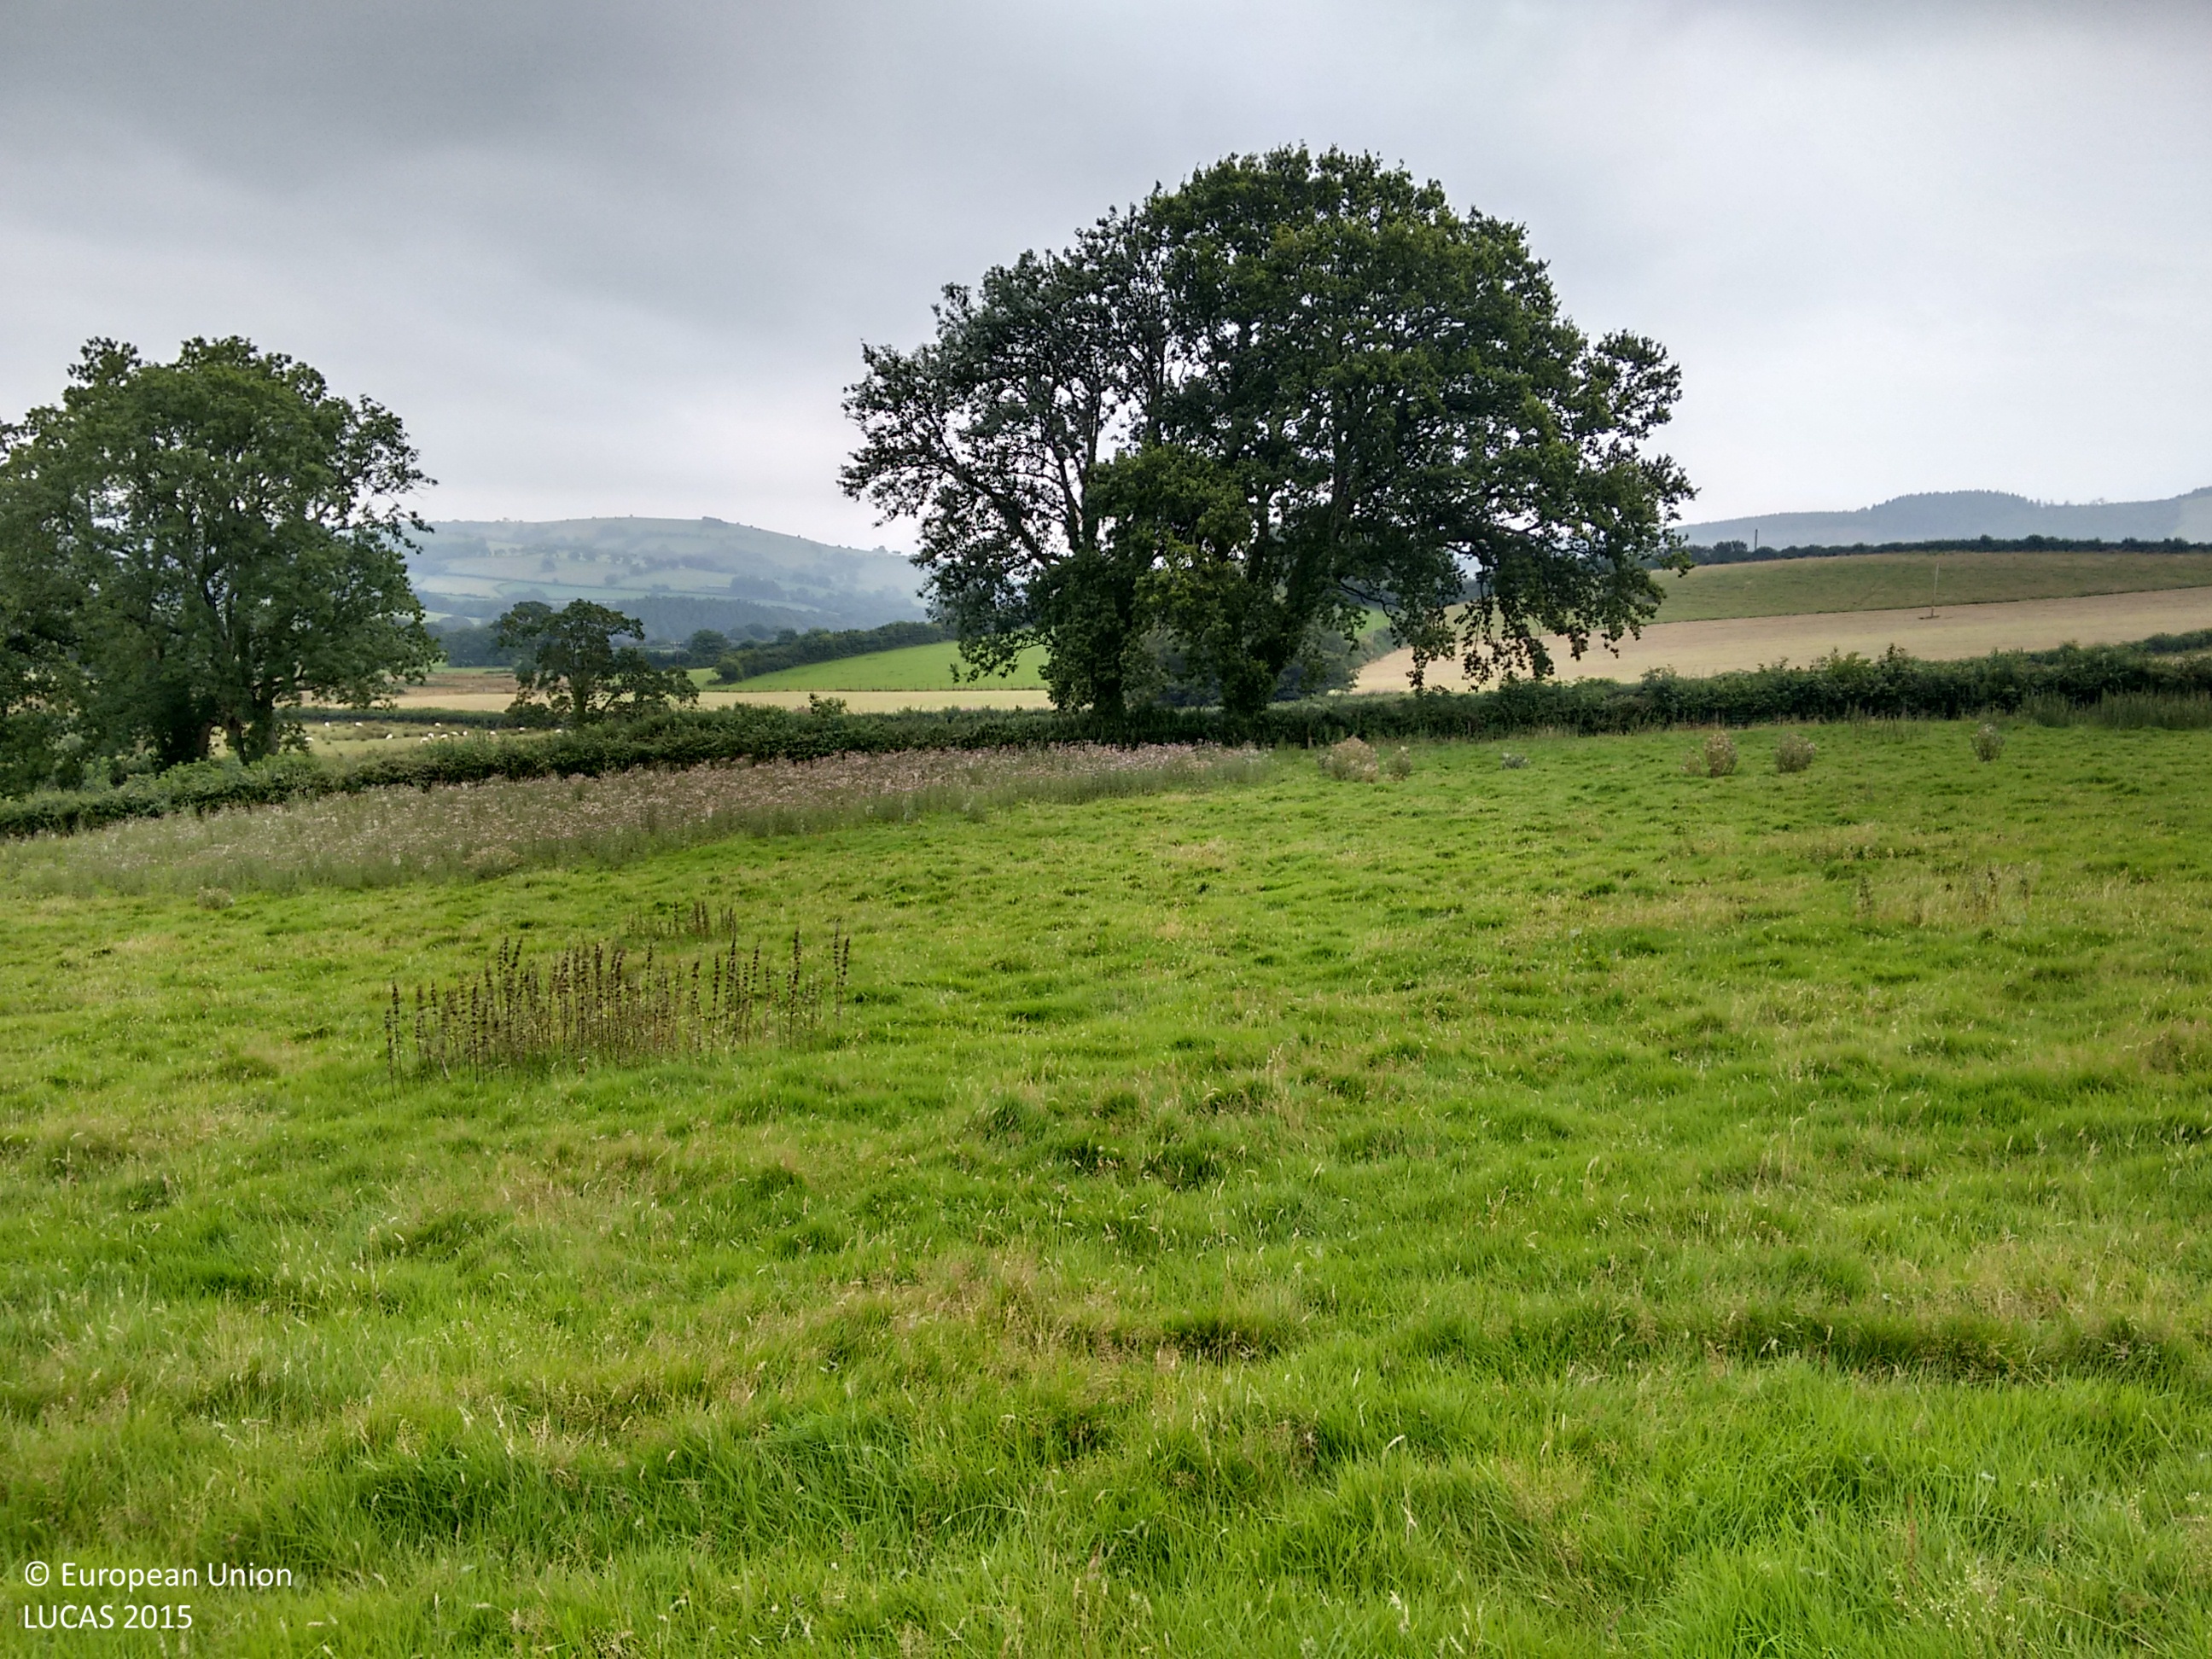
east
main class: Grassland
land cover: Grassland without tree/shrub cover
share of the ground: > 75 %
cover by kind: herbaceous plants 100 %
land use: Agriculture (excluding fallow land and kitchen gardens)
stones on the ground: < 10 %
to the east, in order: Grassland without tree/shrub cover; Fences; Managed hedges; Tracks; Managed hedges; Single bushes/trees; Fences; Grassland without tree/shrub cover; Managed hedges; Fences; Managed hedges; Grassland without tree/shrub cover; Fences; Shruby margins; Inland fresh water bodies
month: August
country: GB
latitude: 51.9205
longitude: -3.8908
